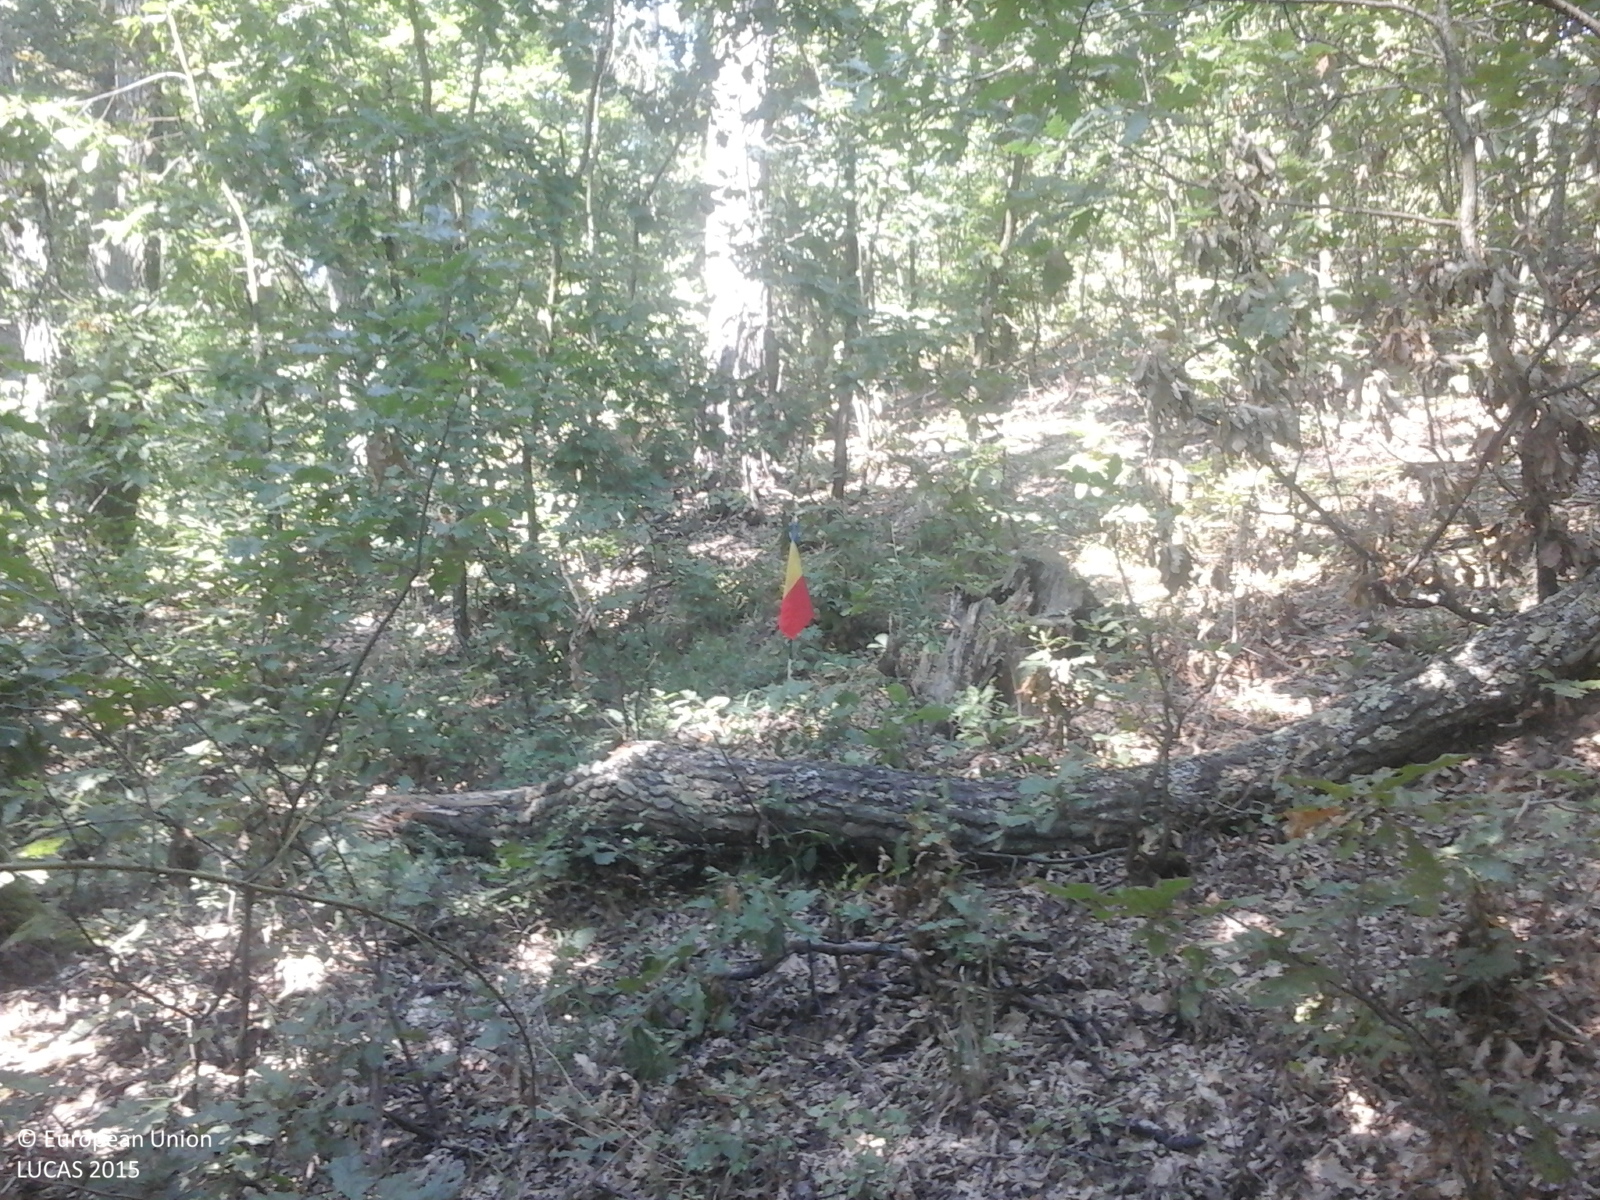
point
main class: Woodland
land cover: Broadleaved woodland
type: acidophilous oak and oak-birch forest
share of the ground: > 75 %
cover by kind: broadleaved forest trees 100 %
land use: Forestry
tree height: > 5 m
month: September
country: RO
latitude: 47.3930
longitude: 22.7120
